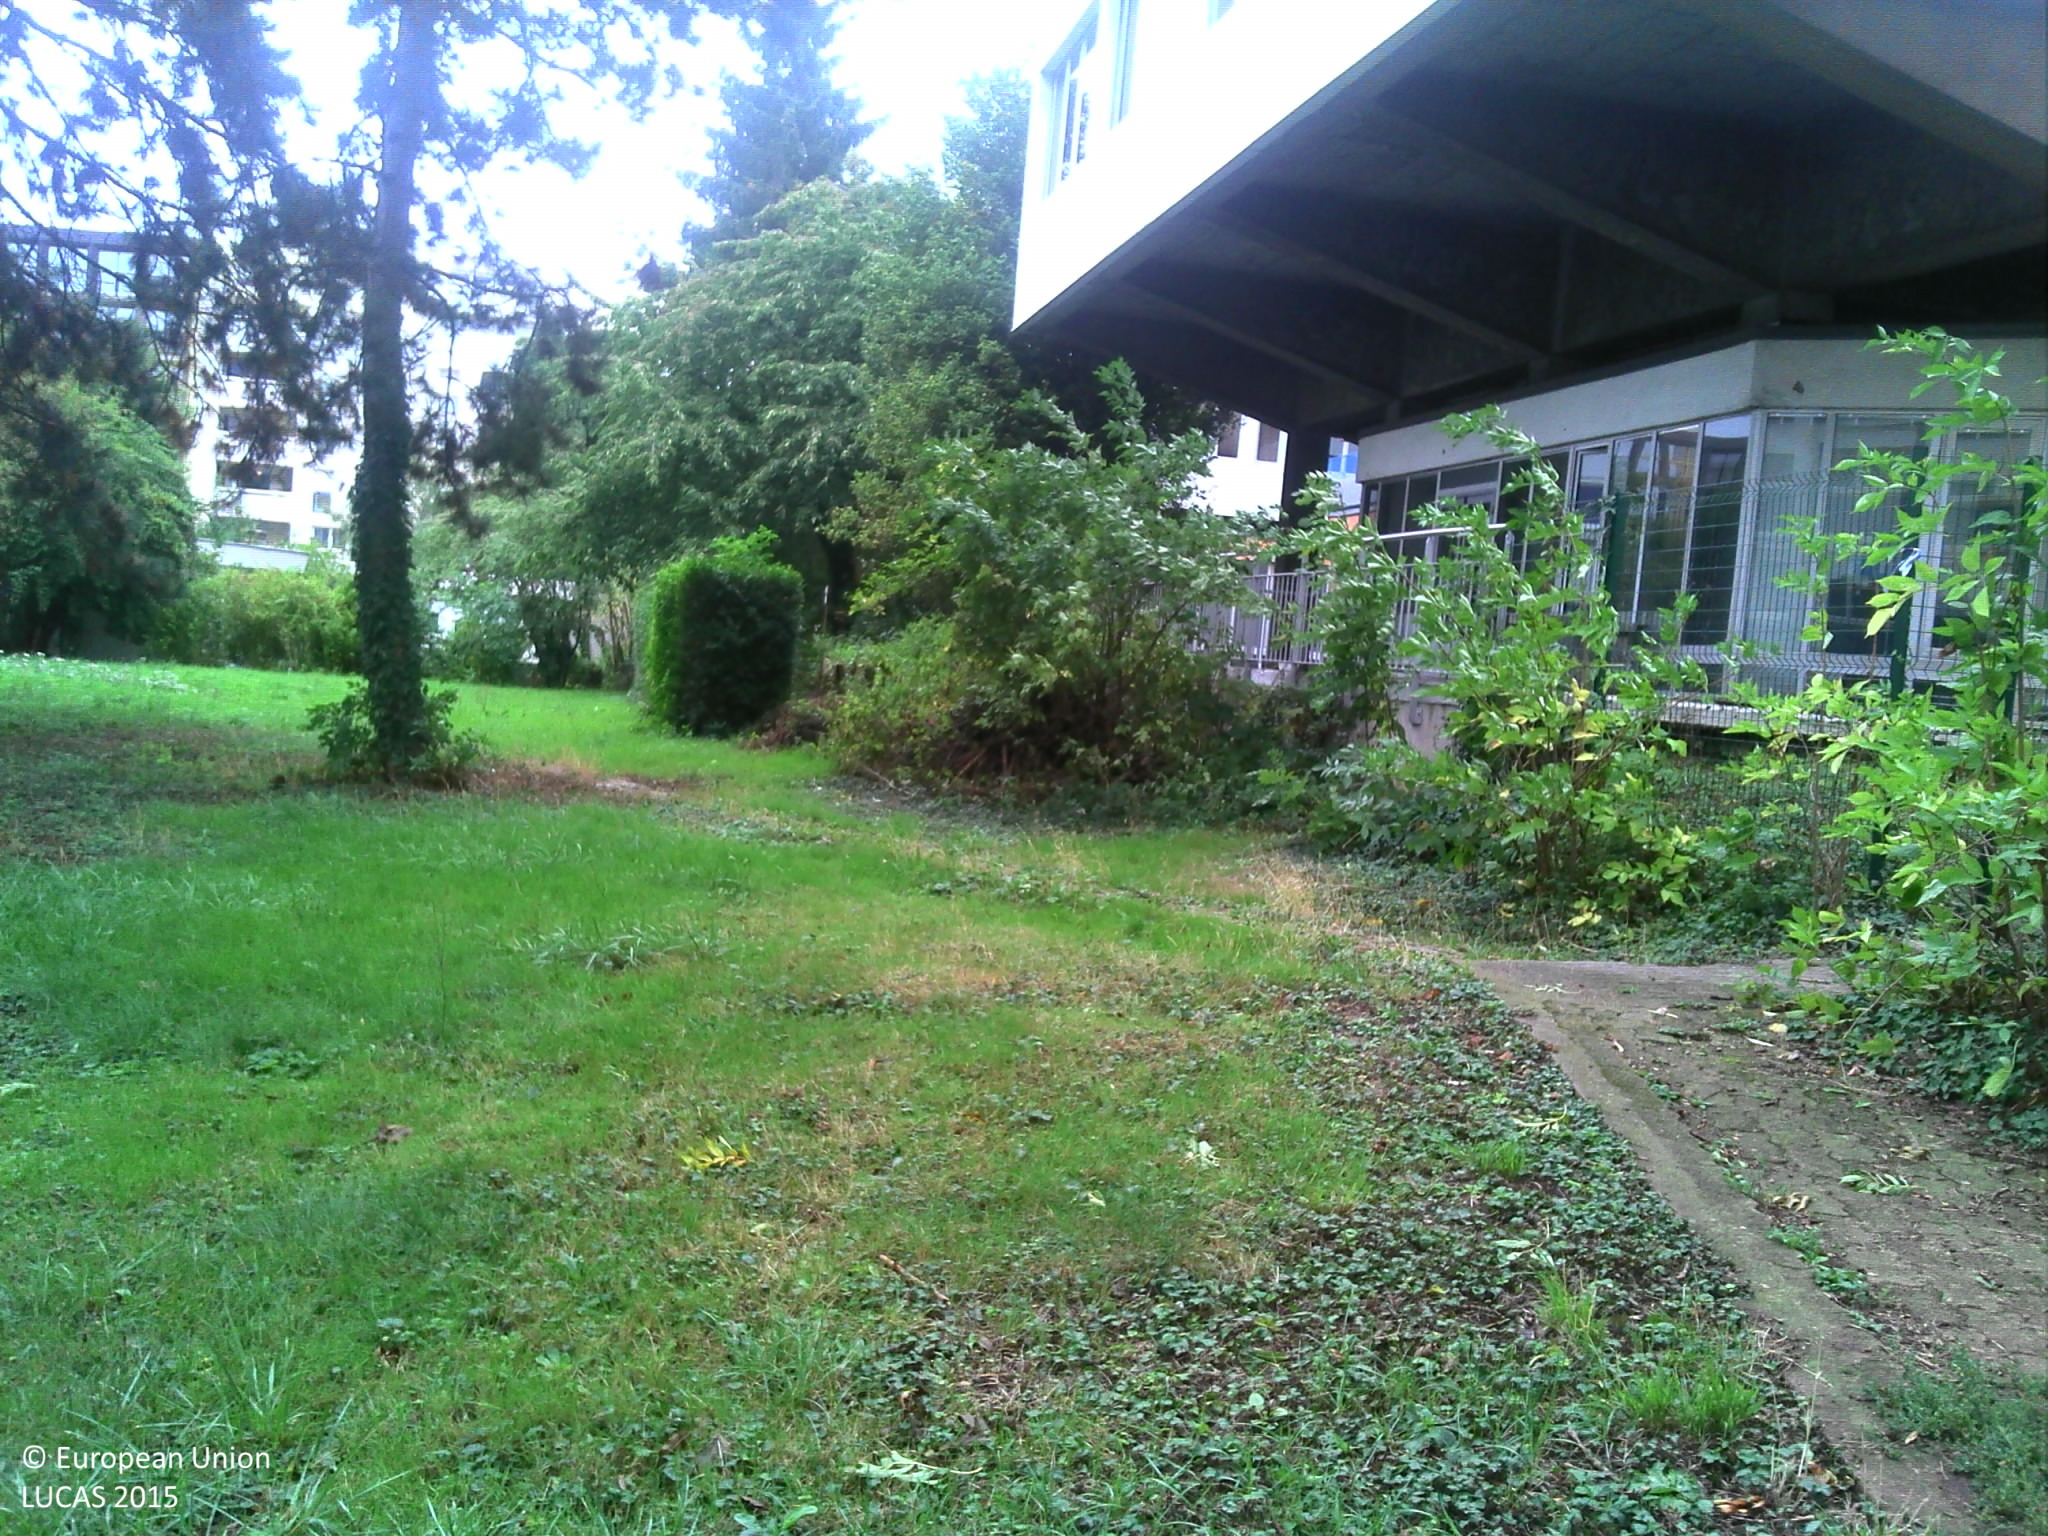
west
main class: Grassland
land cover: Grassland with sparse tree/shrub cover
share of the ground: > 75 %
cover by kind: herbaceous plants 85 %, consolidated bare surface 10 %, broadleaved forest trees 5 %
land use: Residential
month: September
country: FR
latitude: 48.6799
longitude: 6.1835
